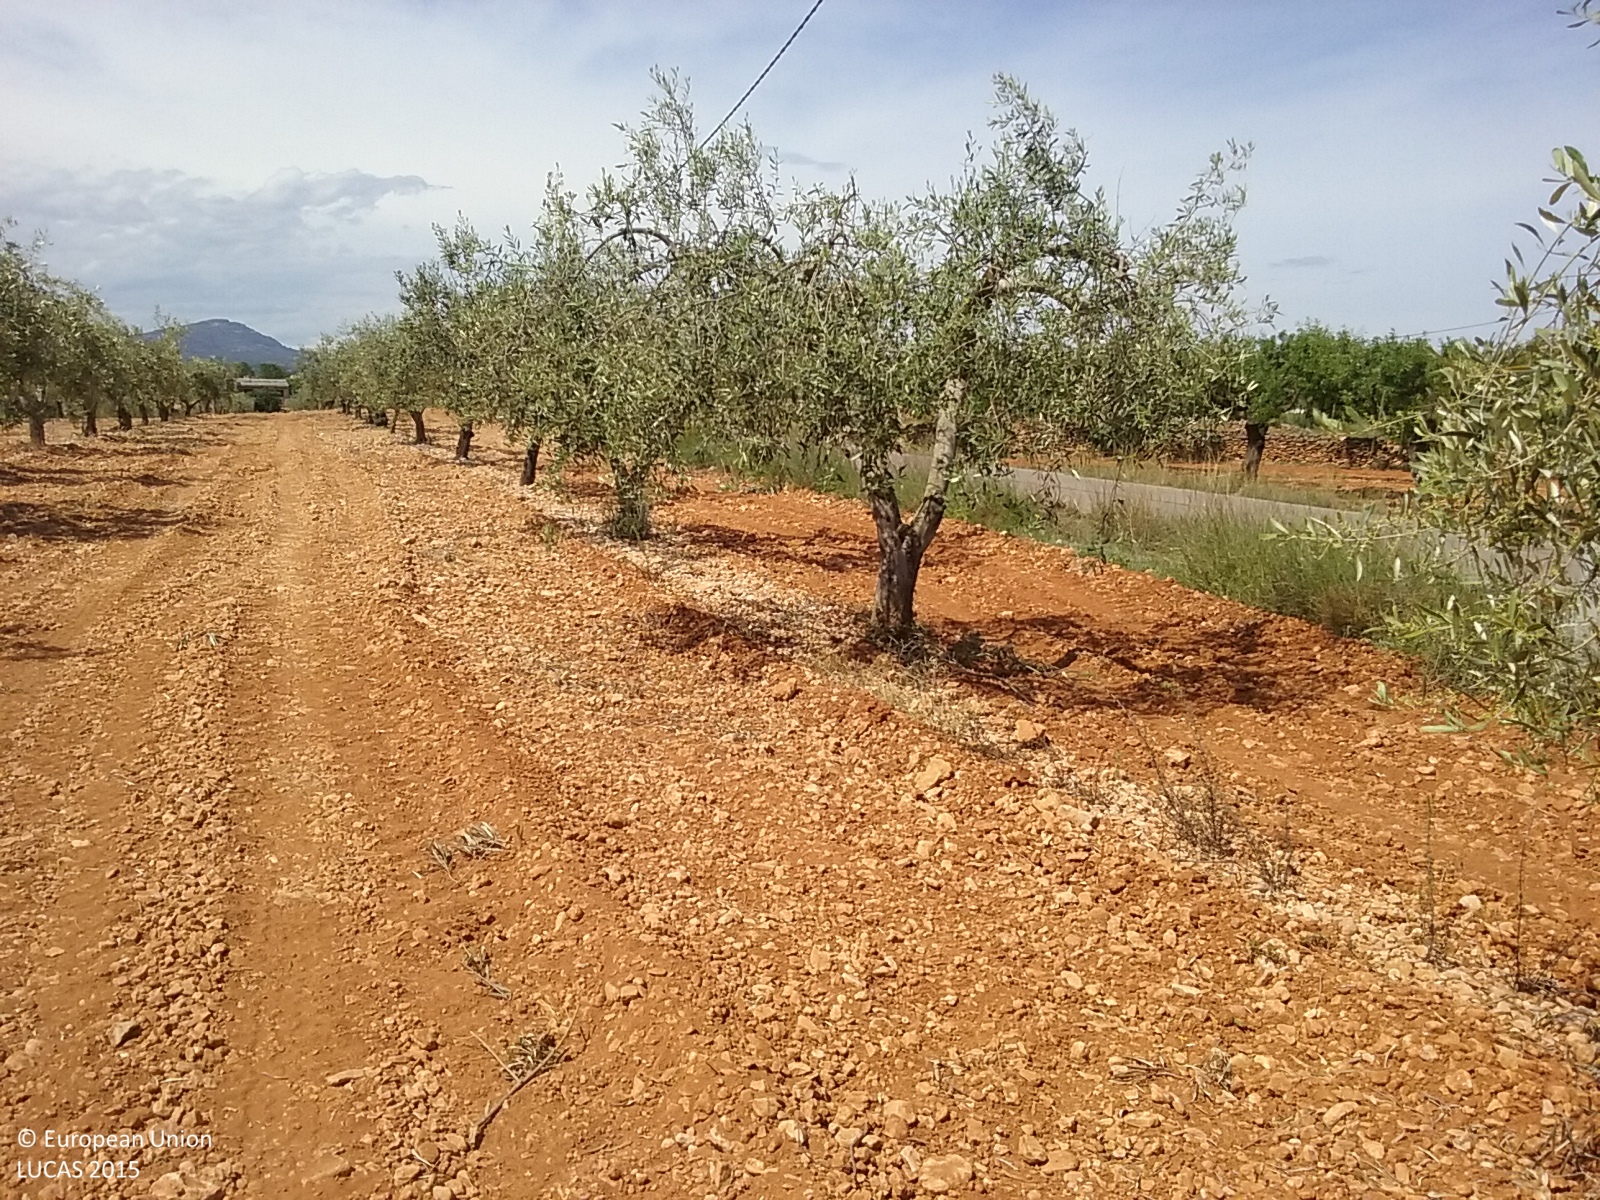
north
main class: Cropland
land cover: Olive groves
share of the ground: 25 - 50 %
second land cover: Other bare soil
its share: > 75 %
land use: Agriculture (excluding fallow land and kitchen gardens)
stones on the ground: 25 - 50 %
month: May
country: ES
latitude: 40.1746
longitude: 0.0039
